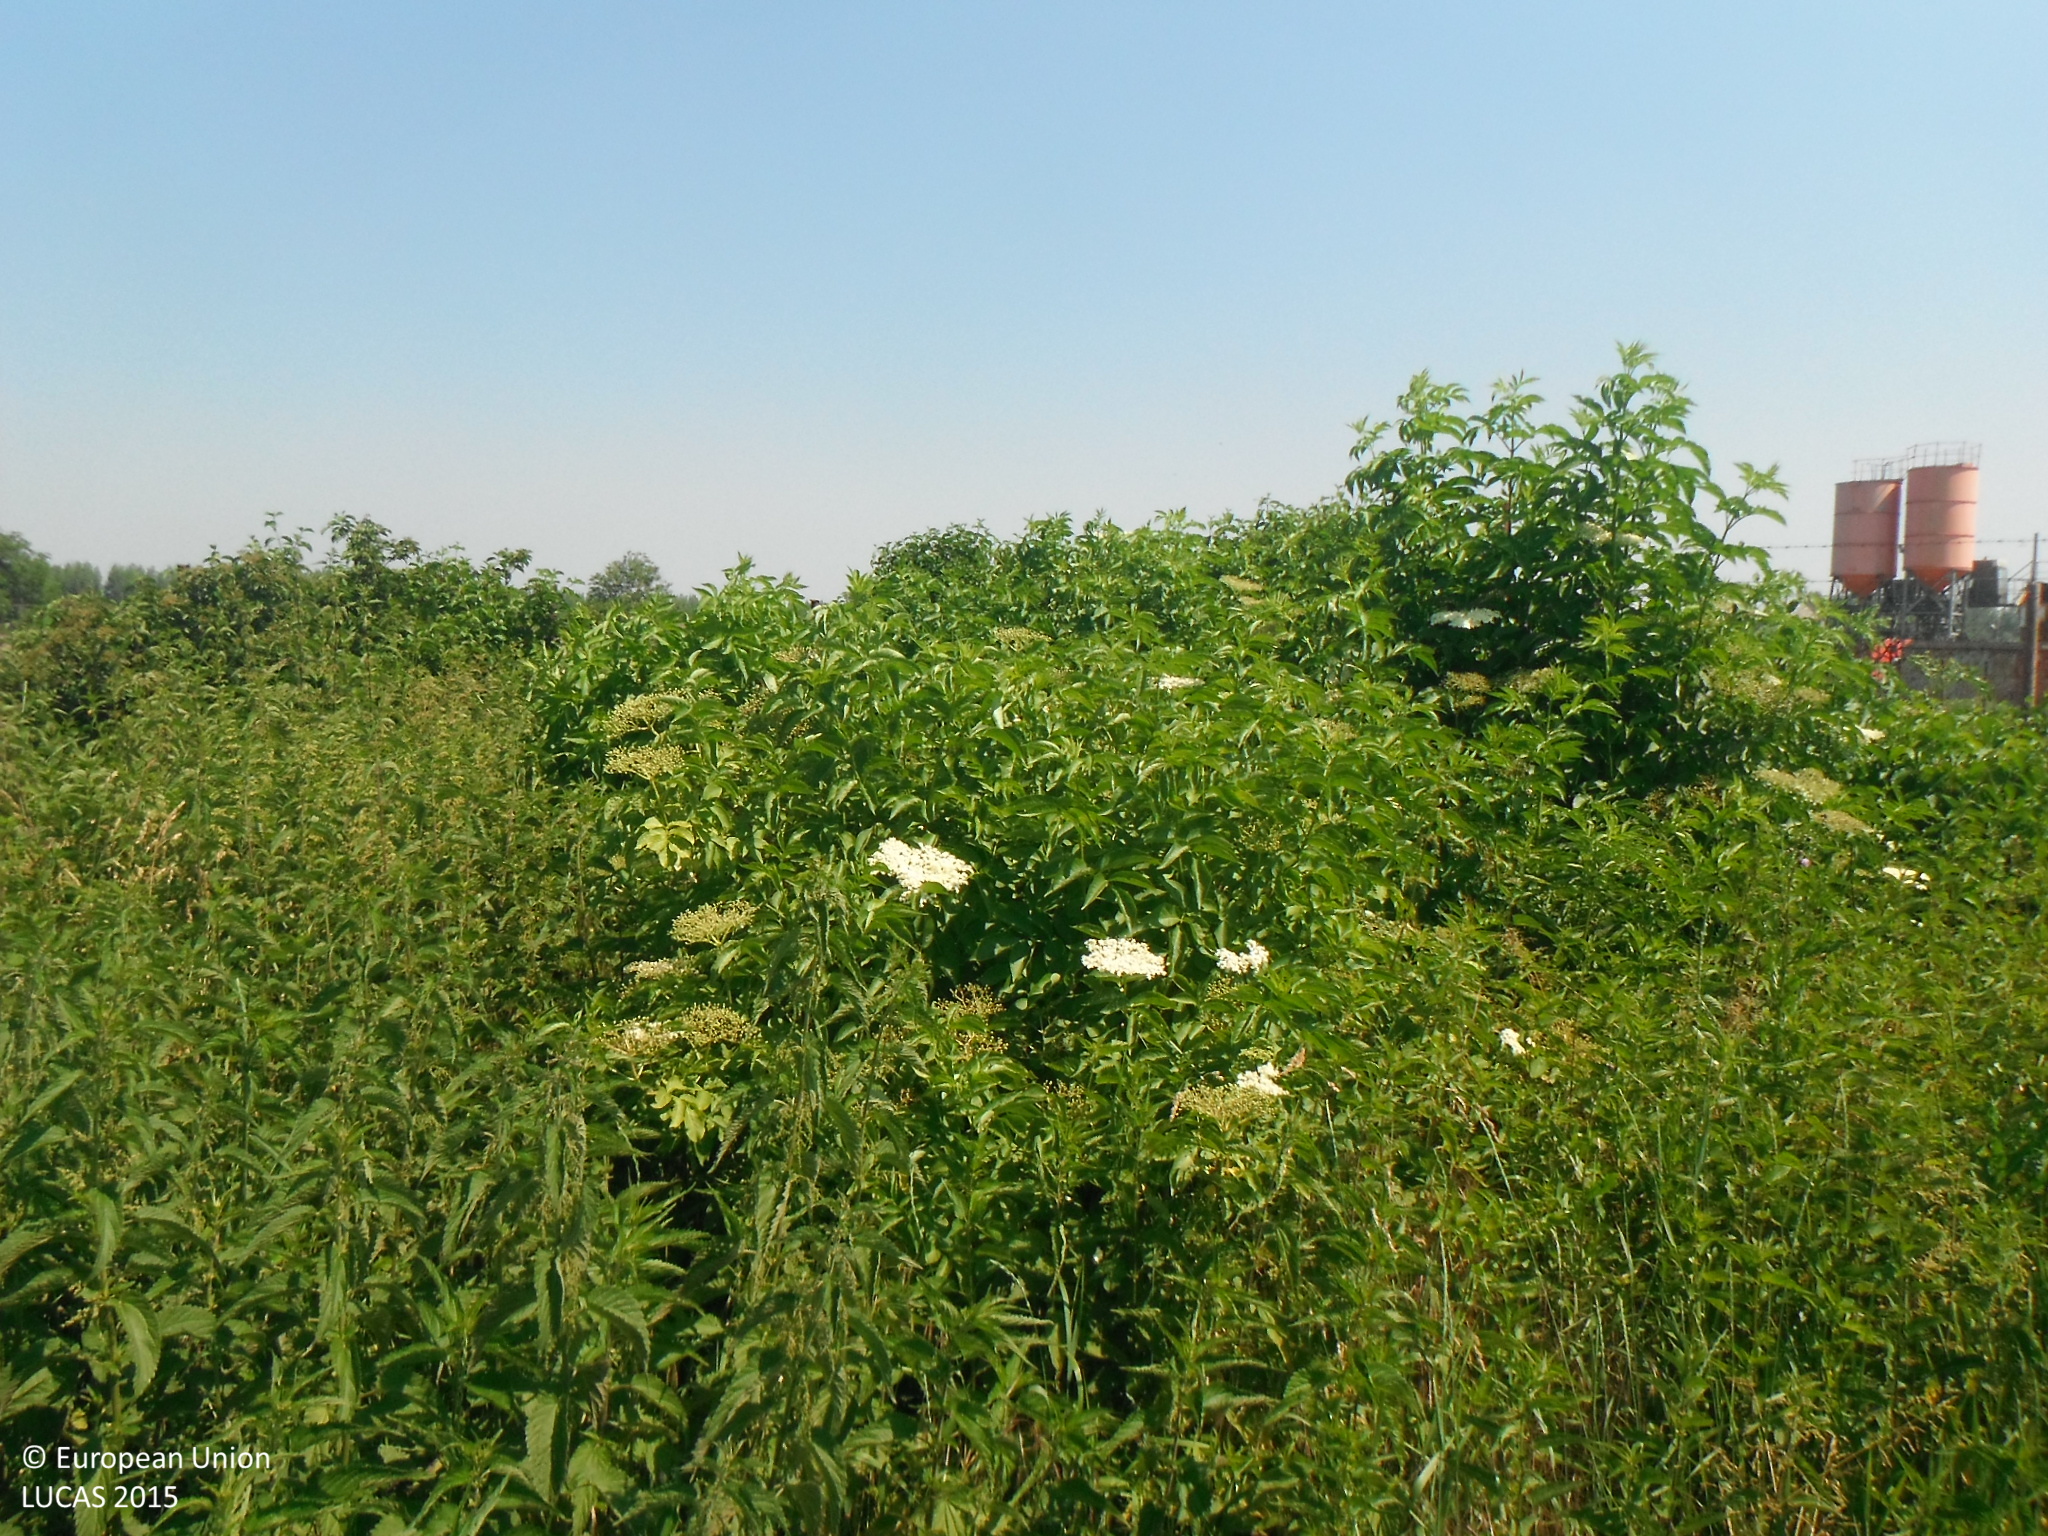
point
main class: Shrubland
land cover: Shrubland without tree cover
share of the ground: > 75 %
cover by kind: herbaceous plants 80 %, shrubs 20 %
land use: Abandoned areas
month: June
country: SK
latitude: 48.0454
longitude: 17.9399
